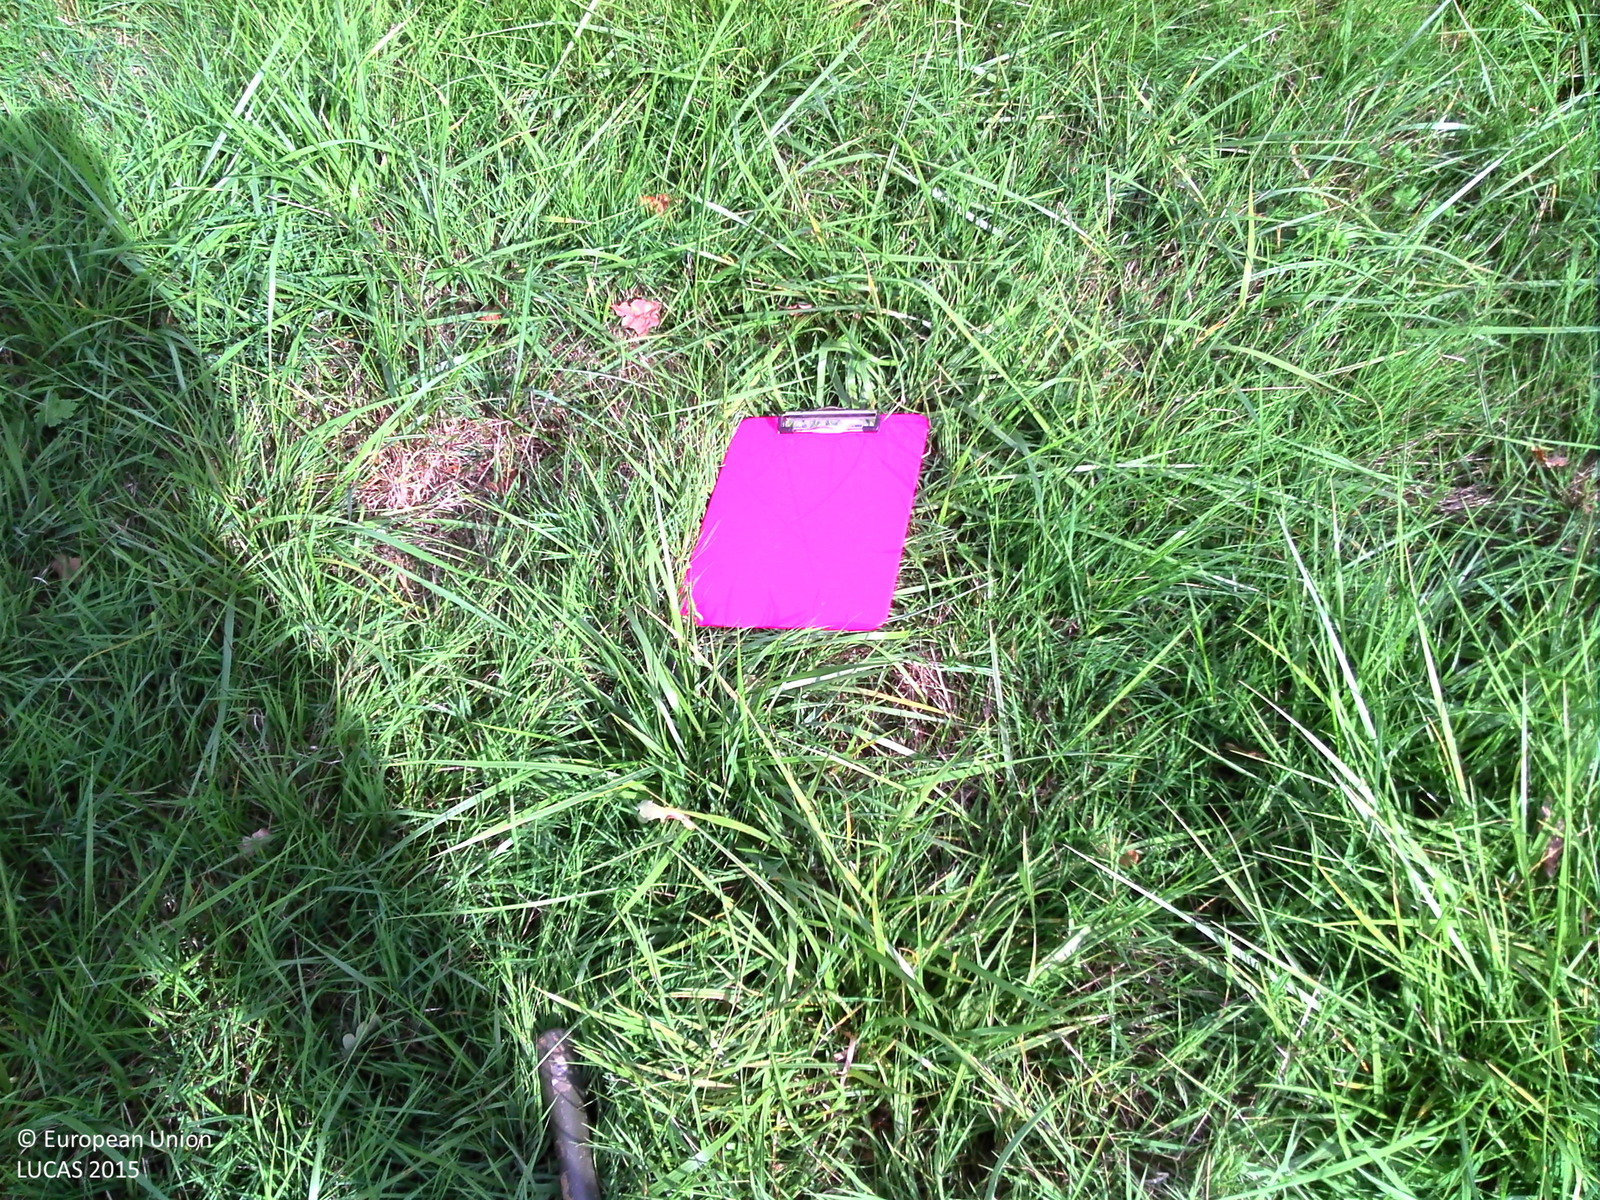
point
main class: Grassland
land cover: Grassland without tree/shrub cover
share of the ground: > 75 %
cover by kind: herbaceous plants 100 %
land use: Agriculture (excluding fallow land and kitchen gardens)
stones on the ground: < 10 %
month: September
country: FR
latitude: 48.5072
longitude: 4.6239
